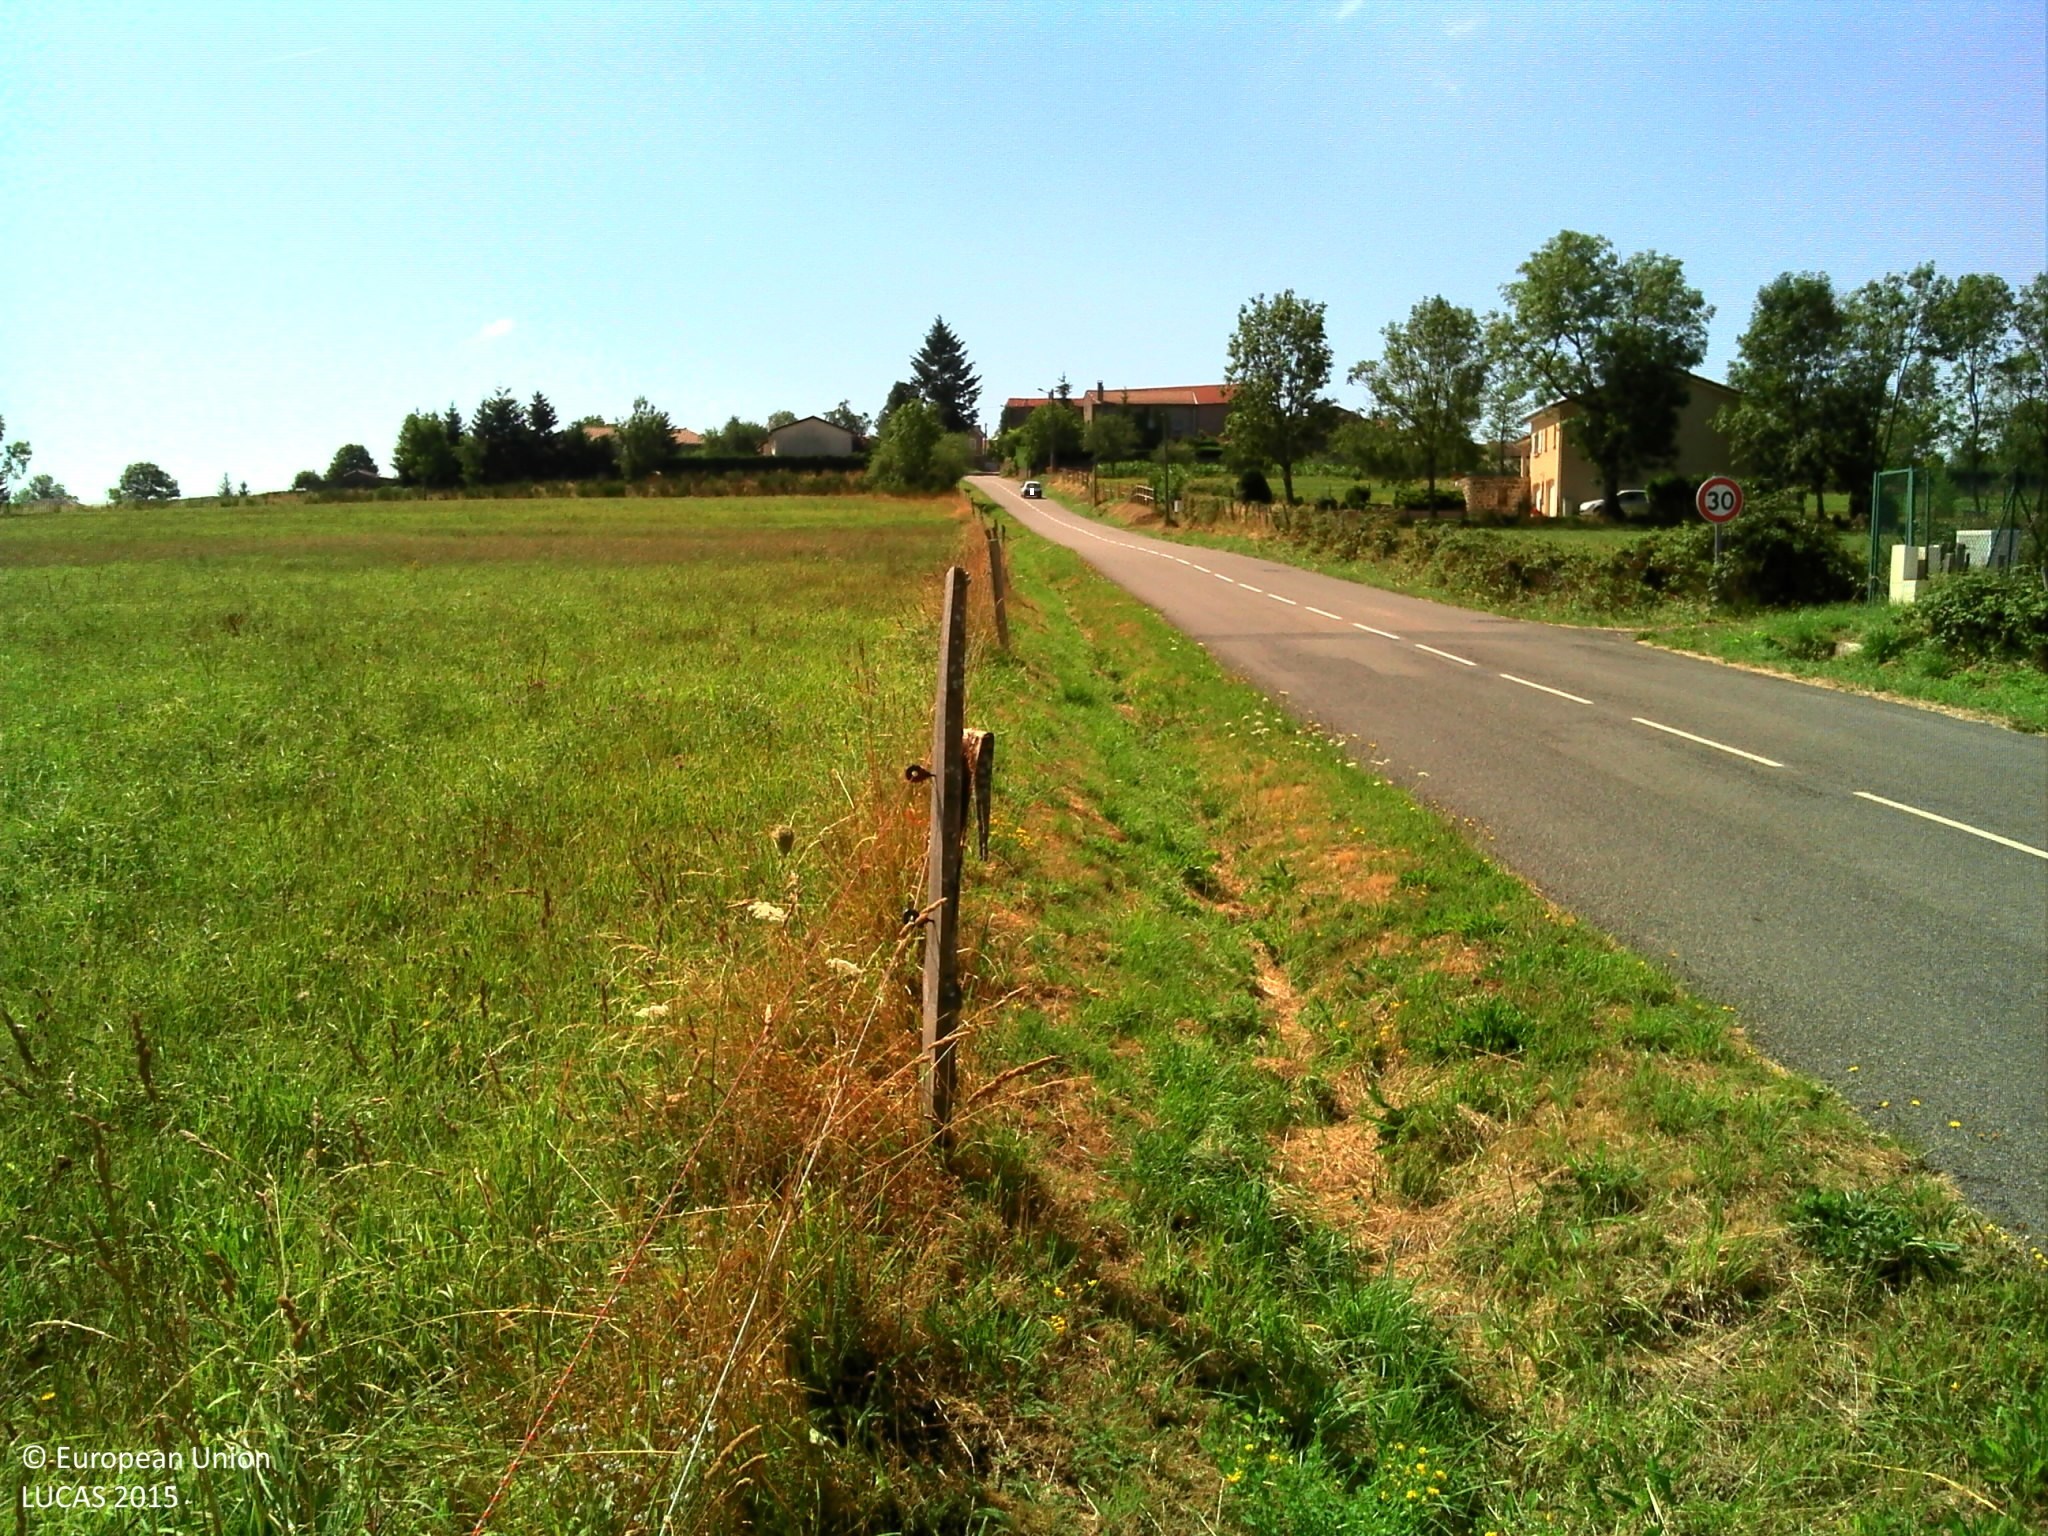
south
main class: Grassland
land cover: Grassland without tree/shrub cover
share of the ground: > 75 %
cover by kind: herbaceous plants 100 %
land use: Agriculture (excluding fallow land and kitchen gardens)
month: August
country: FR
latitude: 45.4180
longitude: 4.2146
